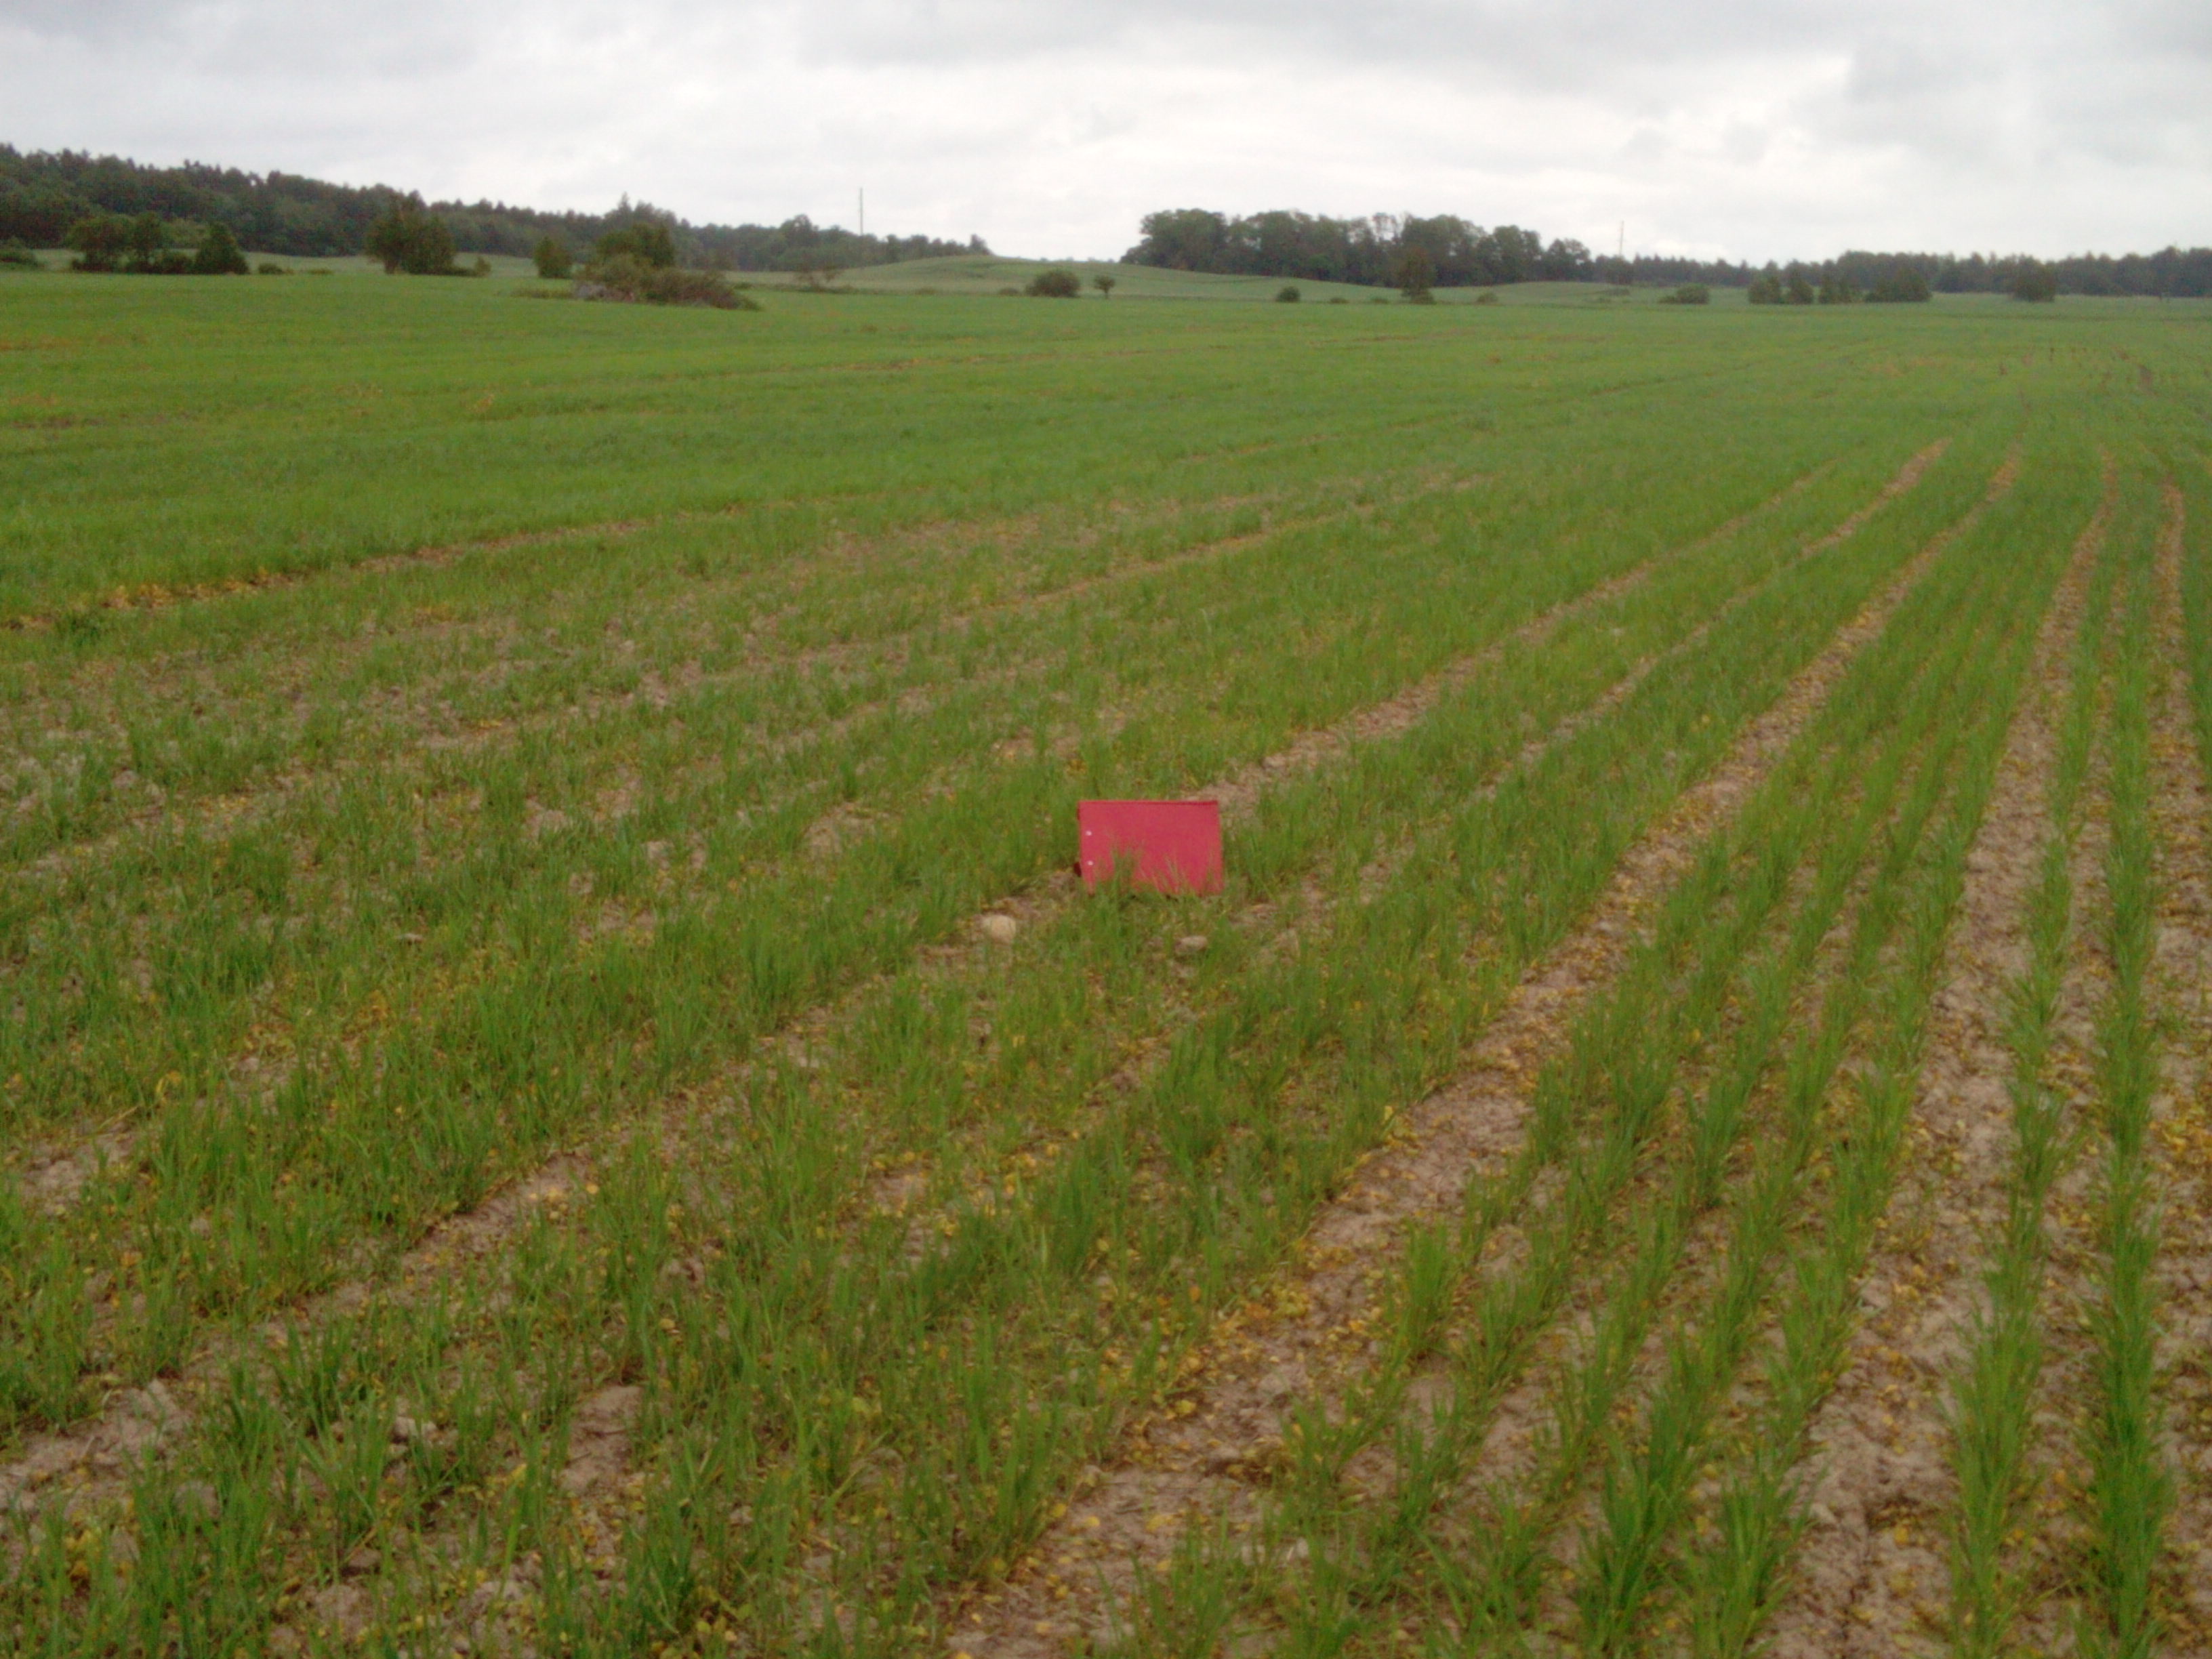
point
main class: Cropland
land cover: Barley
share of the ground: > 75 %
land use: Agriculture (excluding fallow land and kitchen gardens)
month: June
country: LV
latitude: 56.6647
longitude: 22.1411
